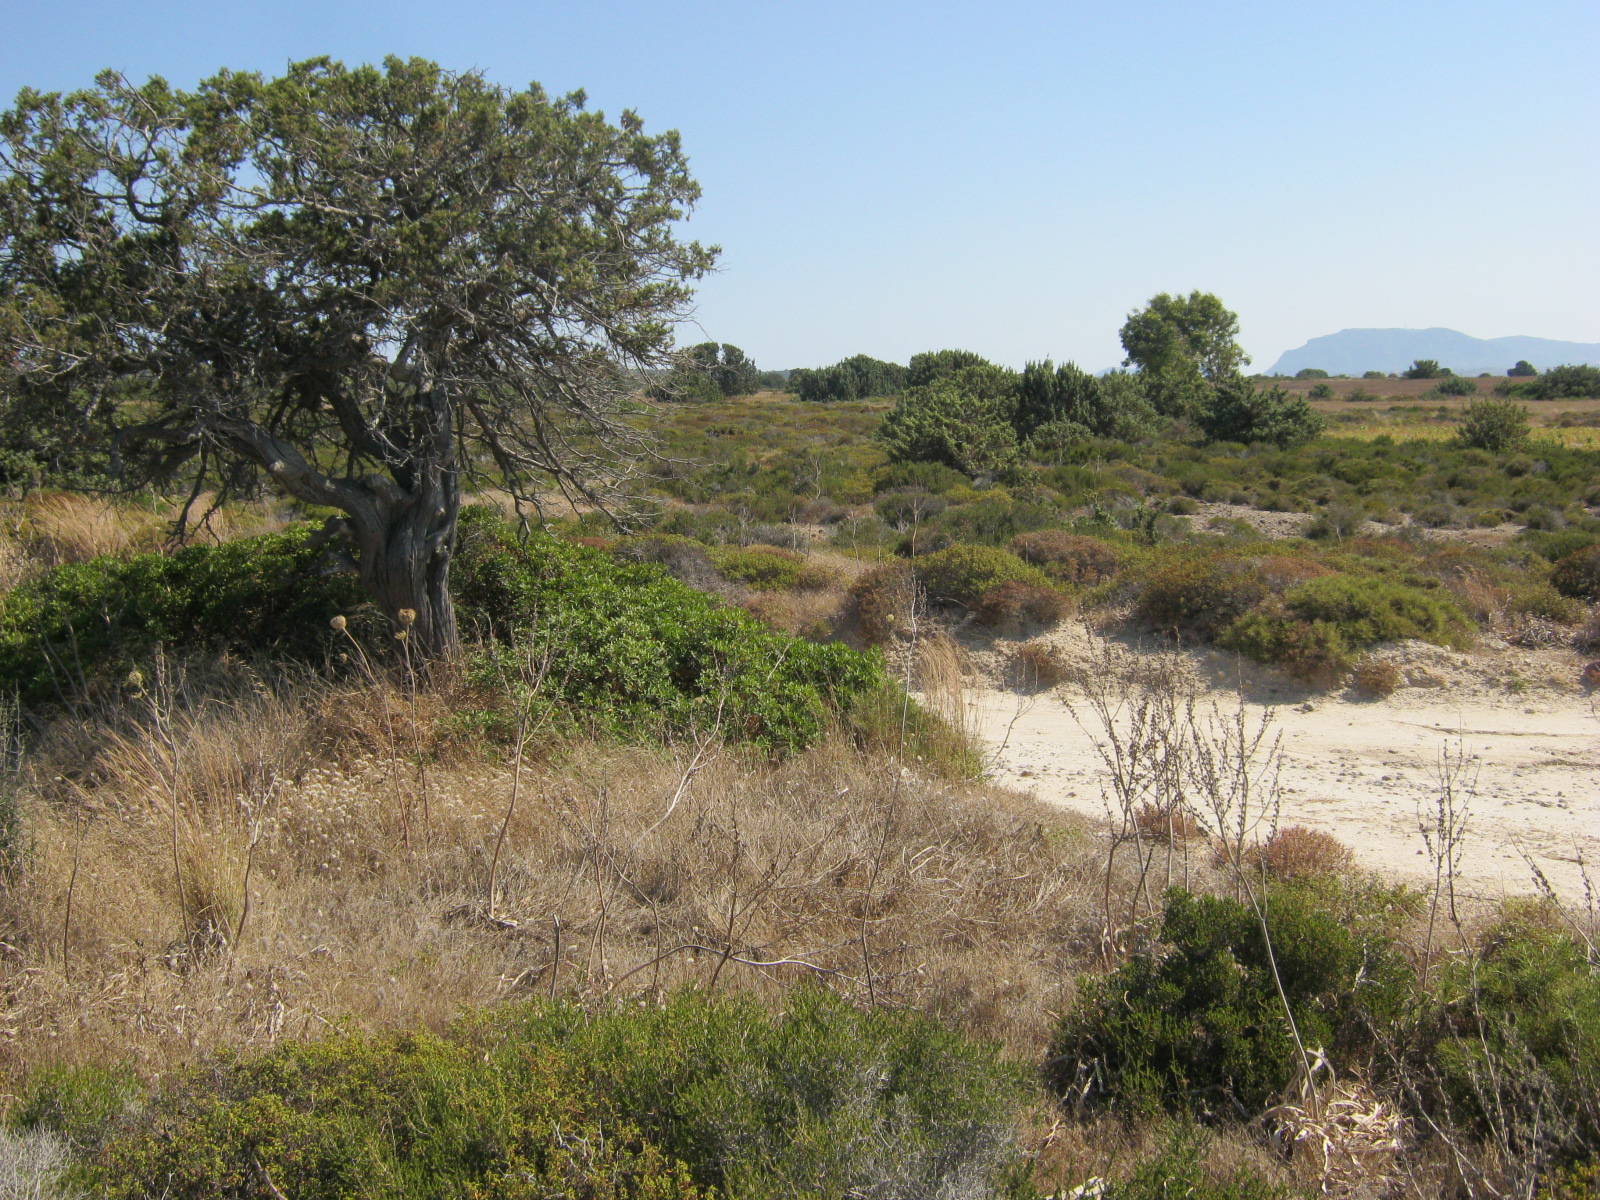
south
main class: Shrubland
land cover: Shrubland with sparse tree cover
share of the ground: > 75 %
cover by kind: shrubs 85 %, consolidated bare surface 10 %, coniferous forest trees 5 %
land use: Semi-natural and natural areas not in use
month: June
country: GR
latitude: 36.8082
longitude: 27.0344
